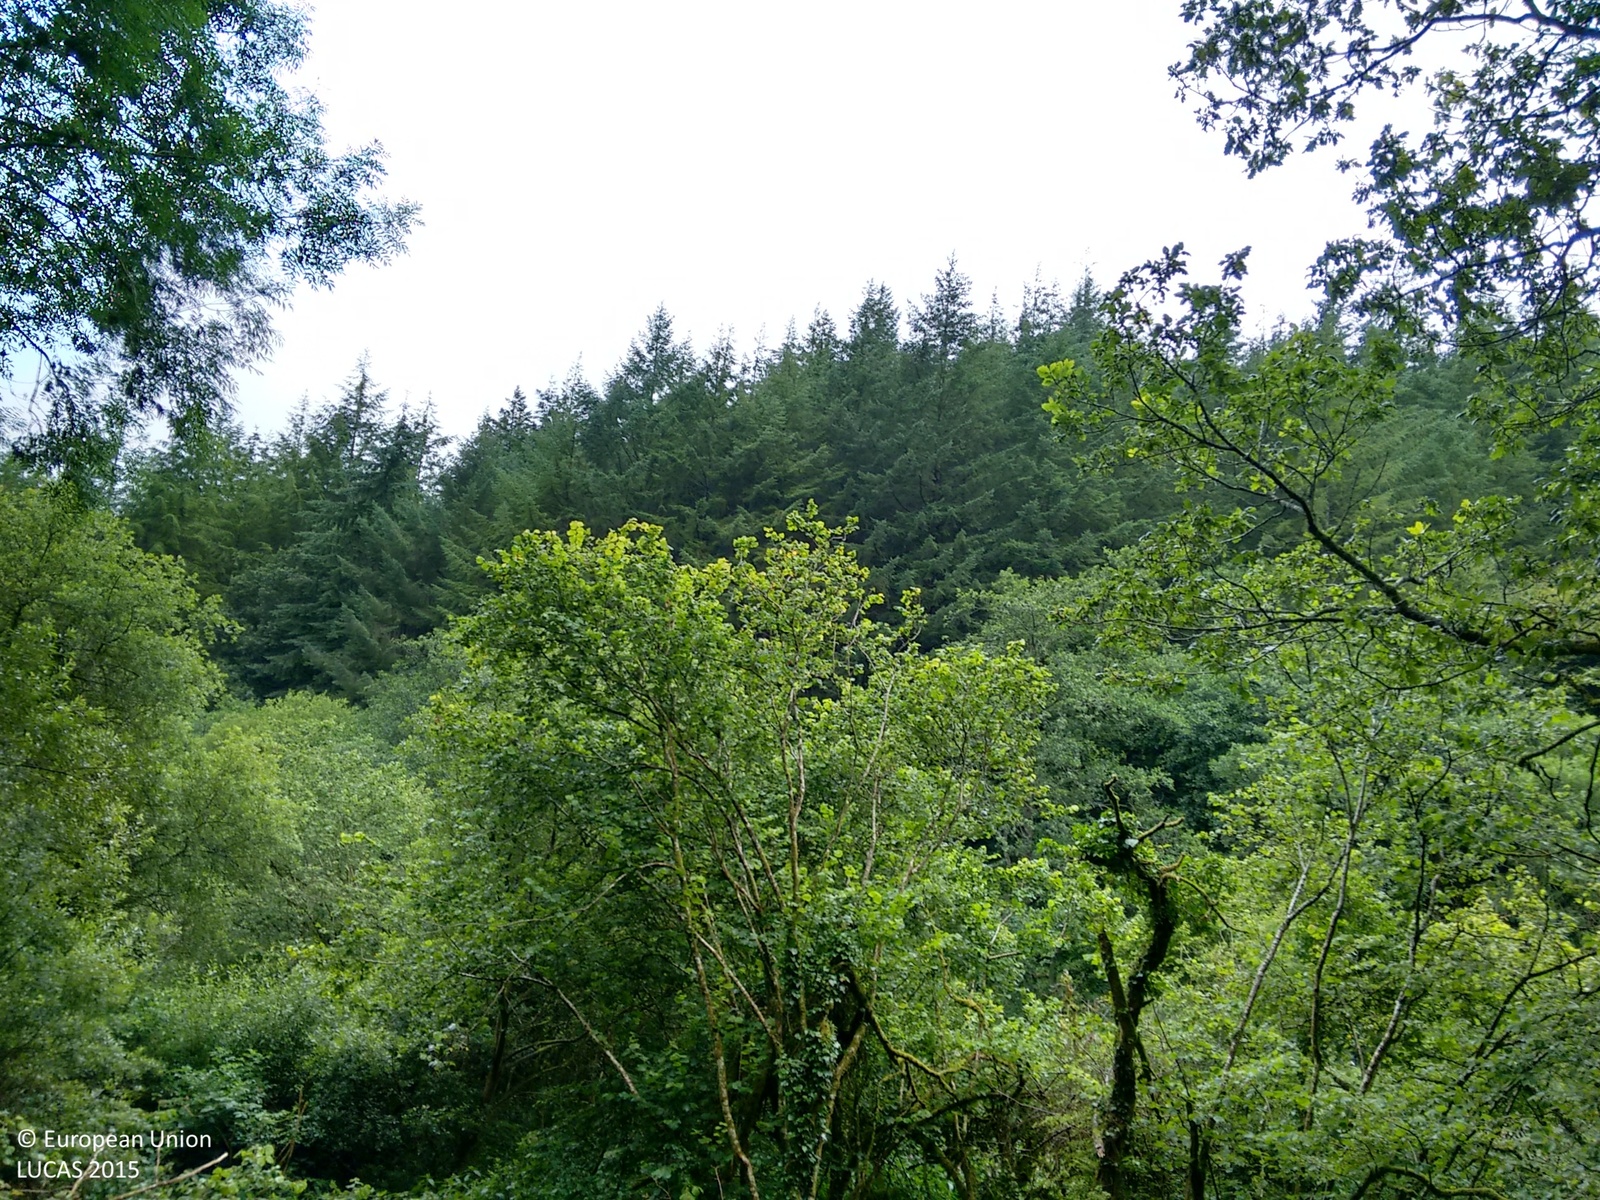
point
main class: Woodland
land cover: Spruce dominated coniferous woodland
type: exotic forest
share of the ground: > 75 %
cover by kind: coniferous forest trees 90 %, shrubs 10 %
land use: Semi-natural and natural areas not in use
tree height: > 5 m
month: August
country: GB
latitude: 51.9001
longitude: -4.5083
